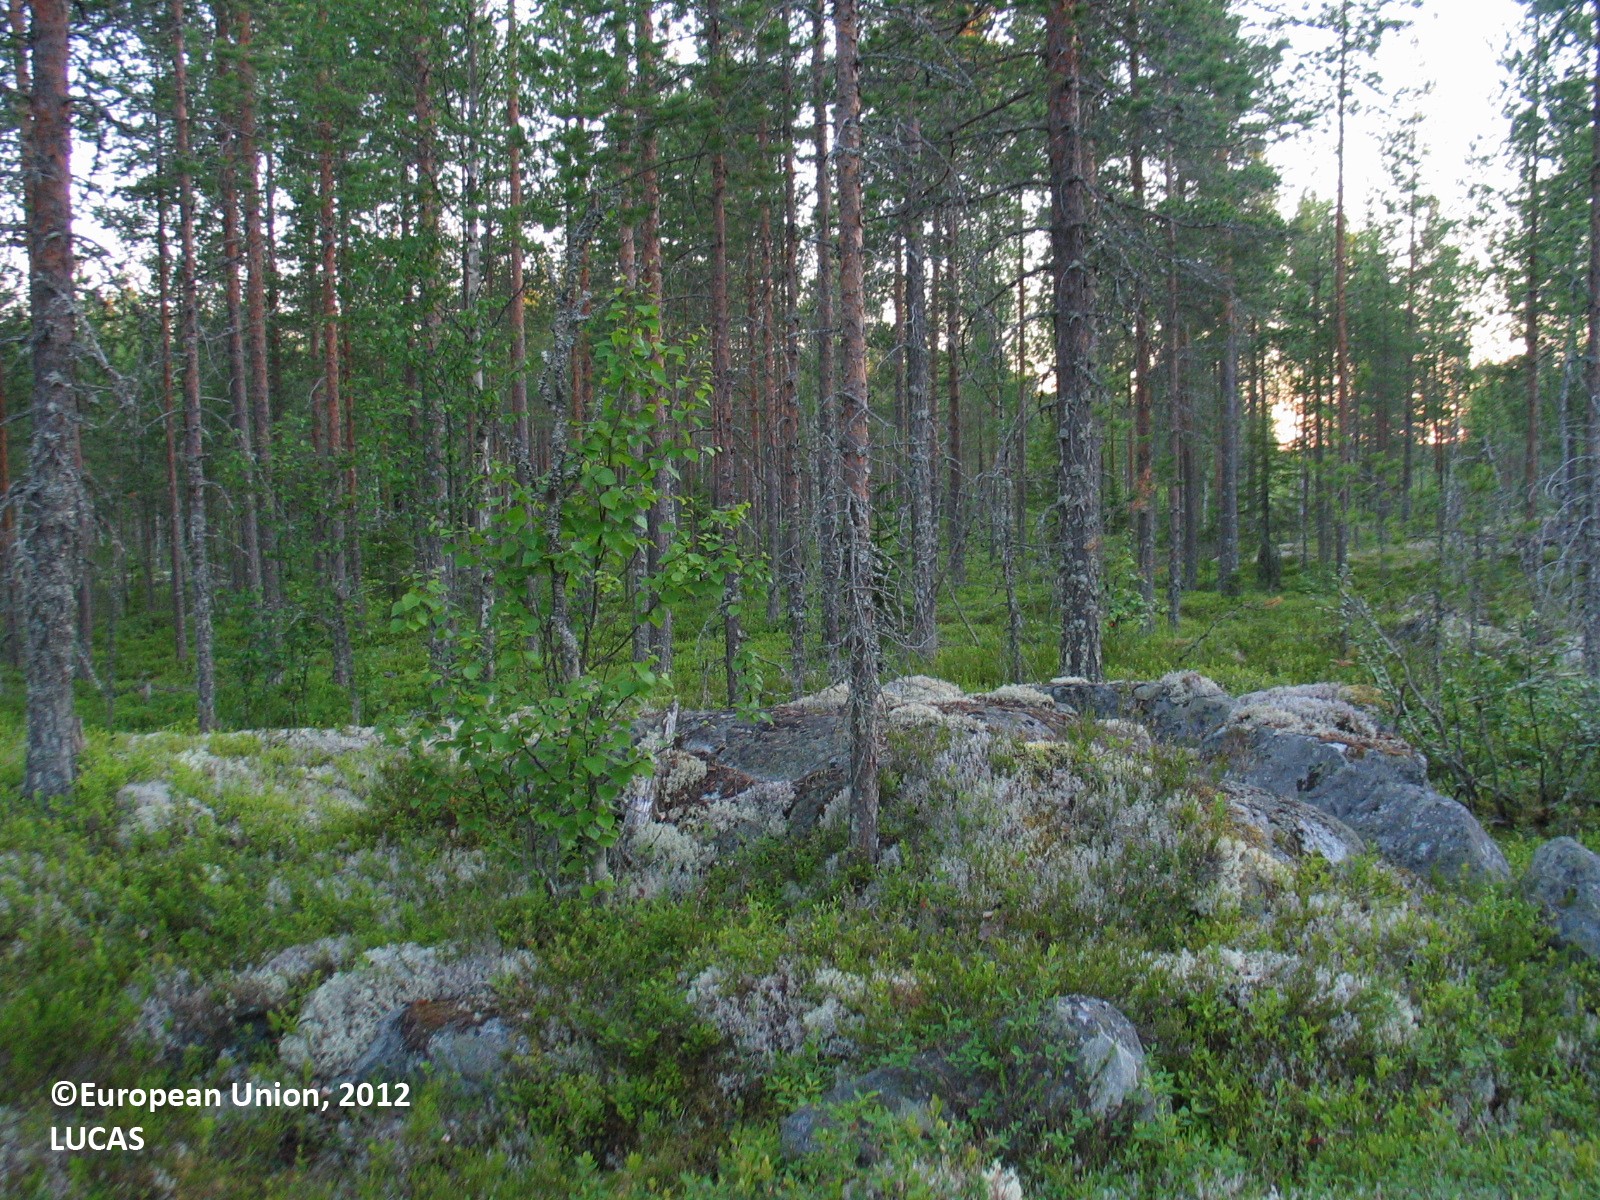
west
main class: Woodland
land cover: Pine dominated coniferous woodland
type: boreal forest
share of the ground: 10 - 25 %
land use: Forestry
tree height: > 5 m
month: July
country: FI
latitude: 64.7695
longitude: 26.6627
